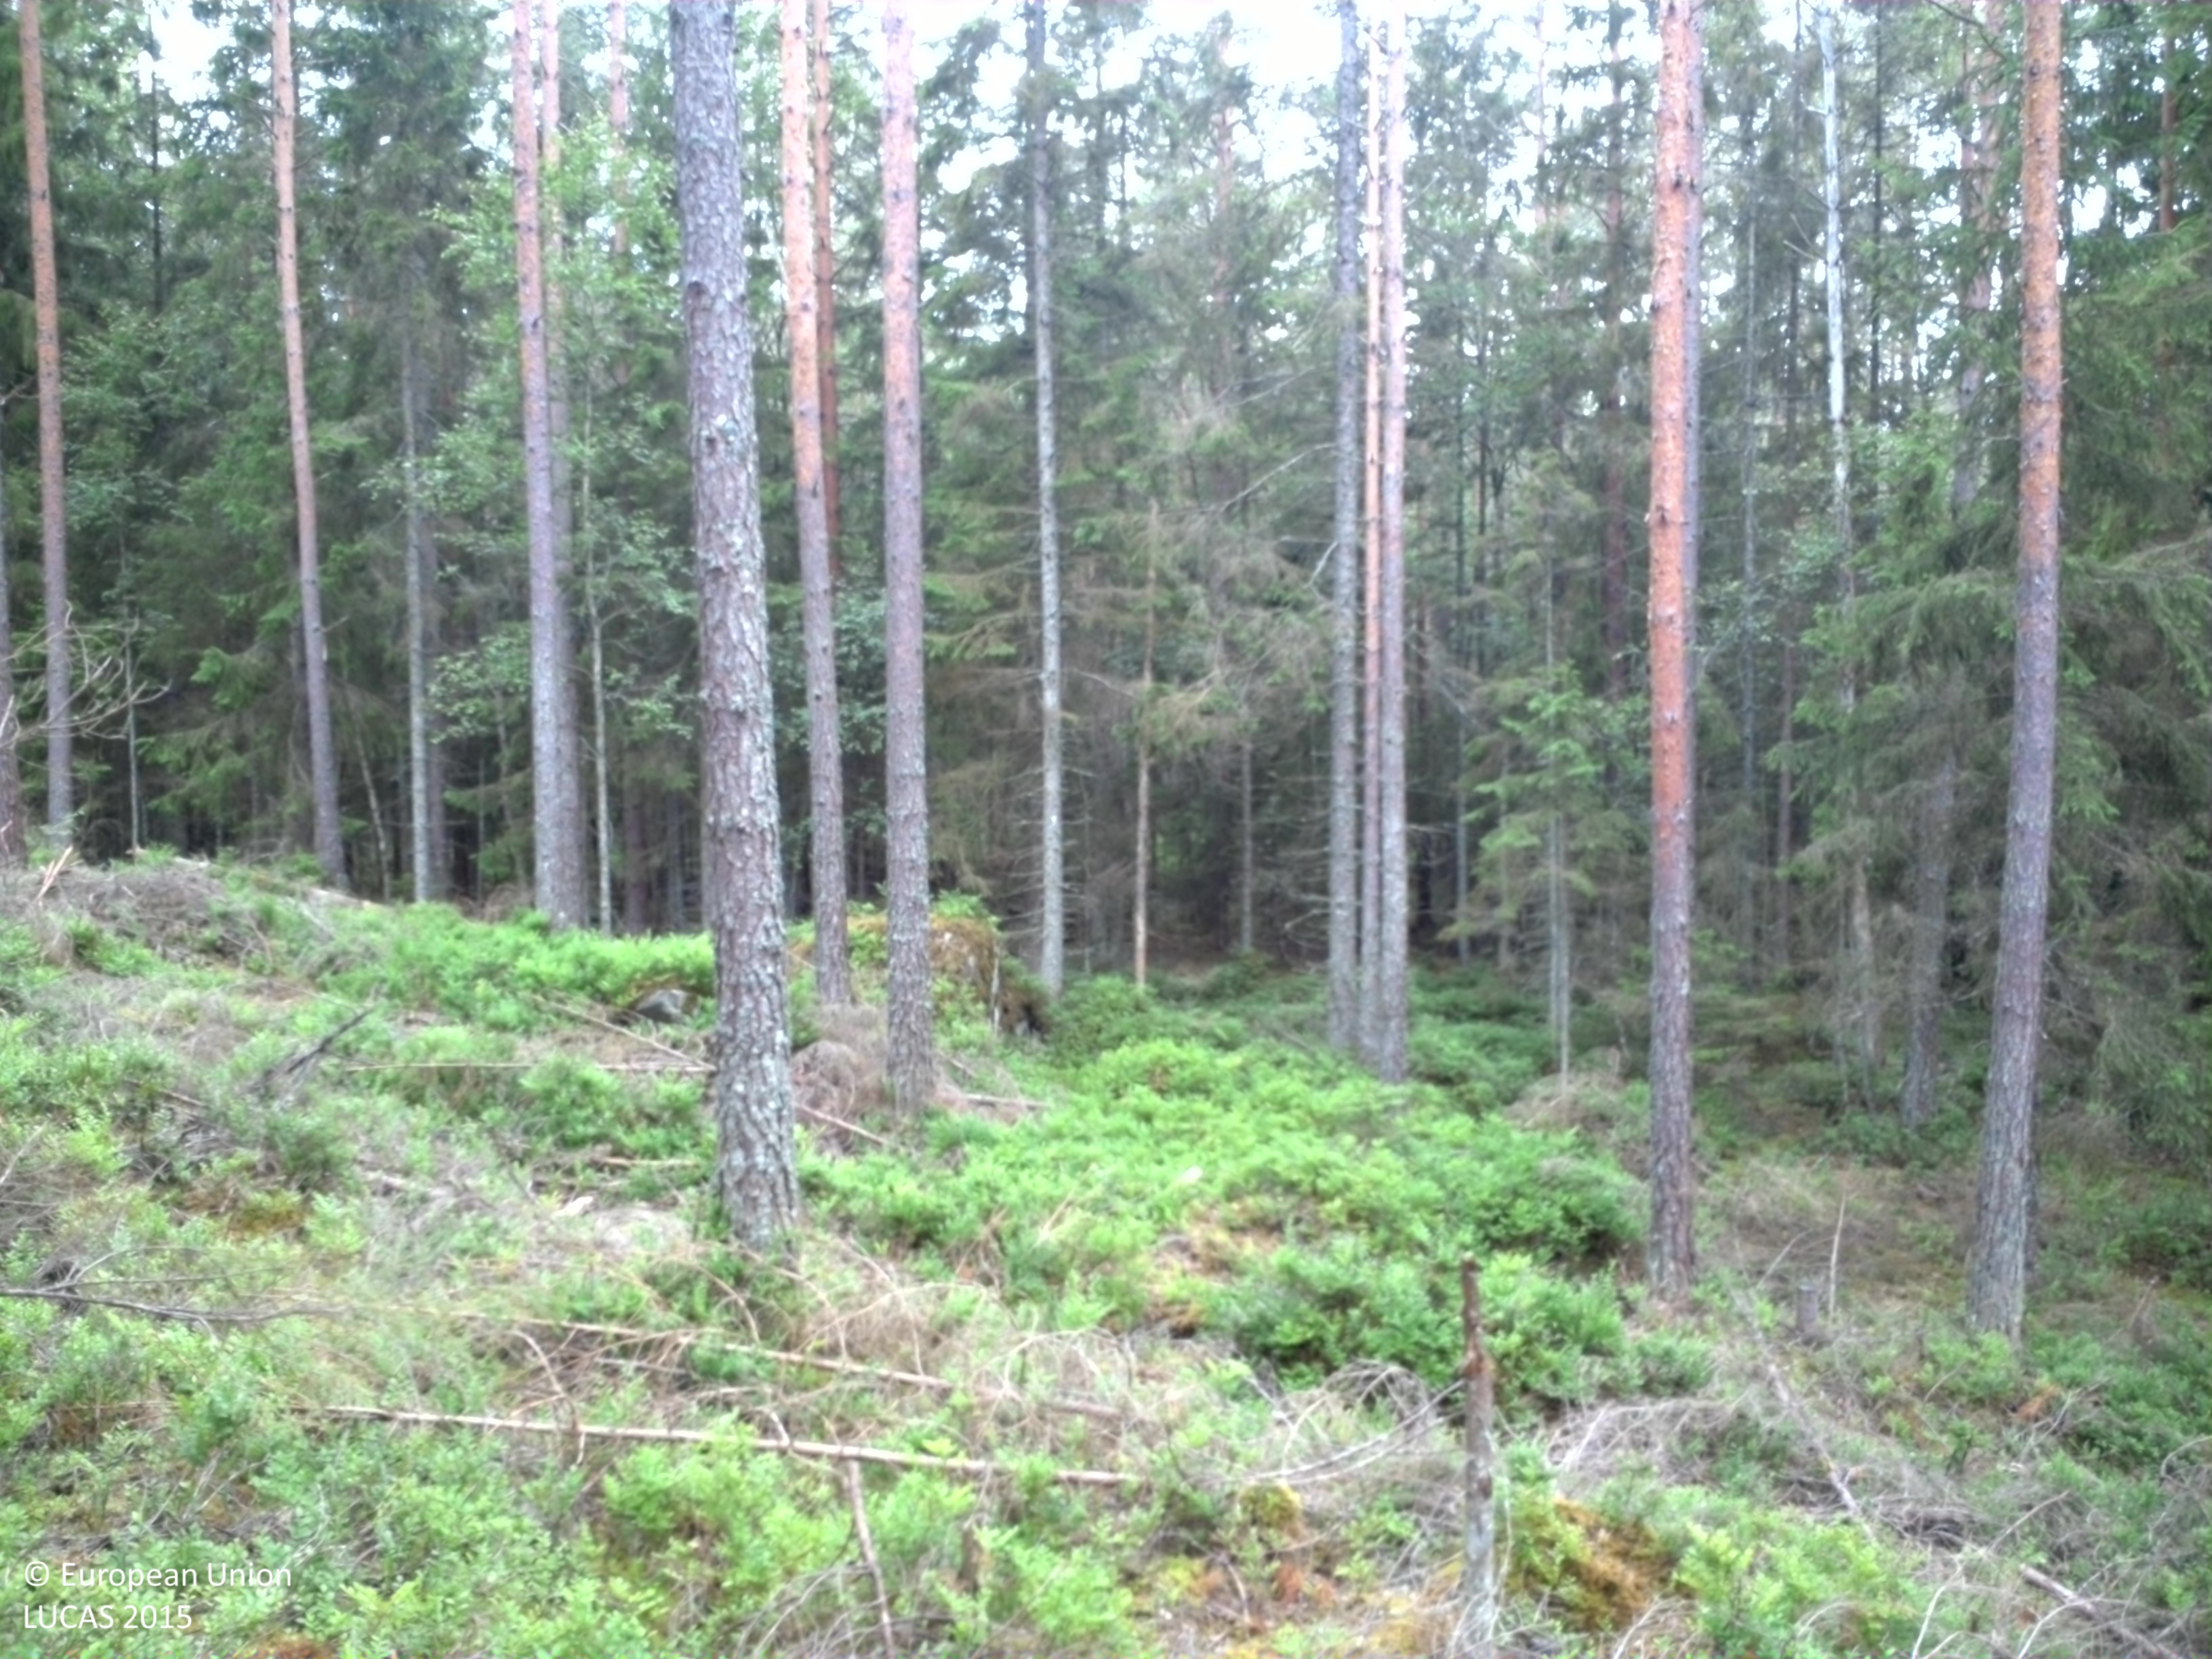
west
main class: Woodland
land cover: Pine dominated coniferous woodland
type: boreal forest
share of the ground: 50 - 75 %
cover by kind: coniferous forest trees 60 %, shrubs 35 %, lichens and mosses 5 %
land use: Forestry
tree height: > 5 m
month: July
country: SE
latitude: 58.7982
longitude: 14.3367
